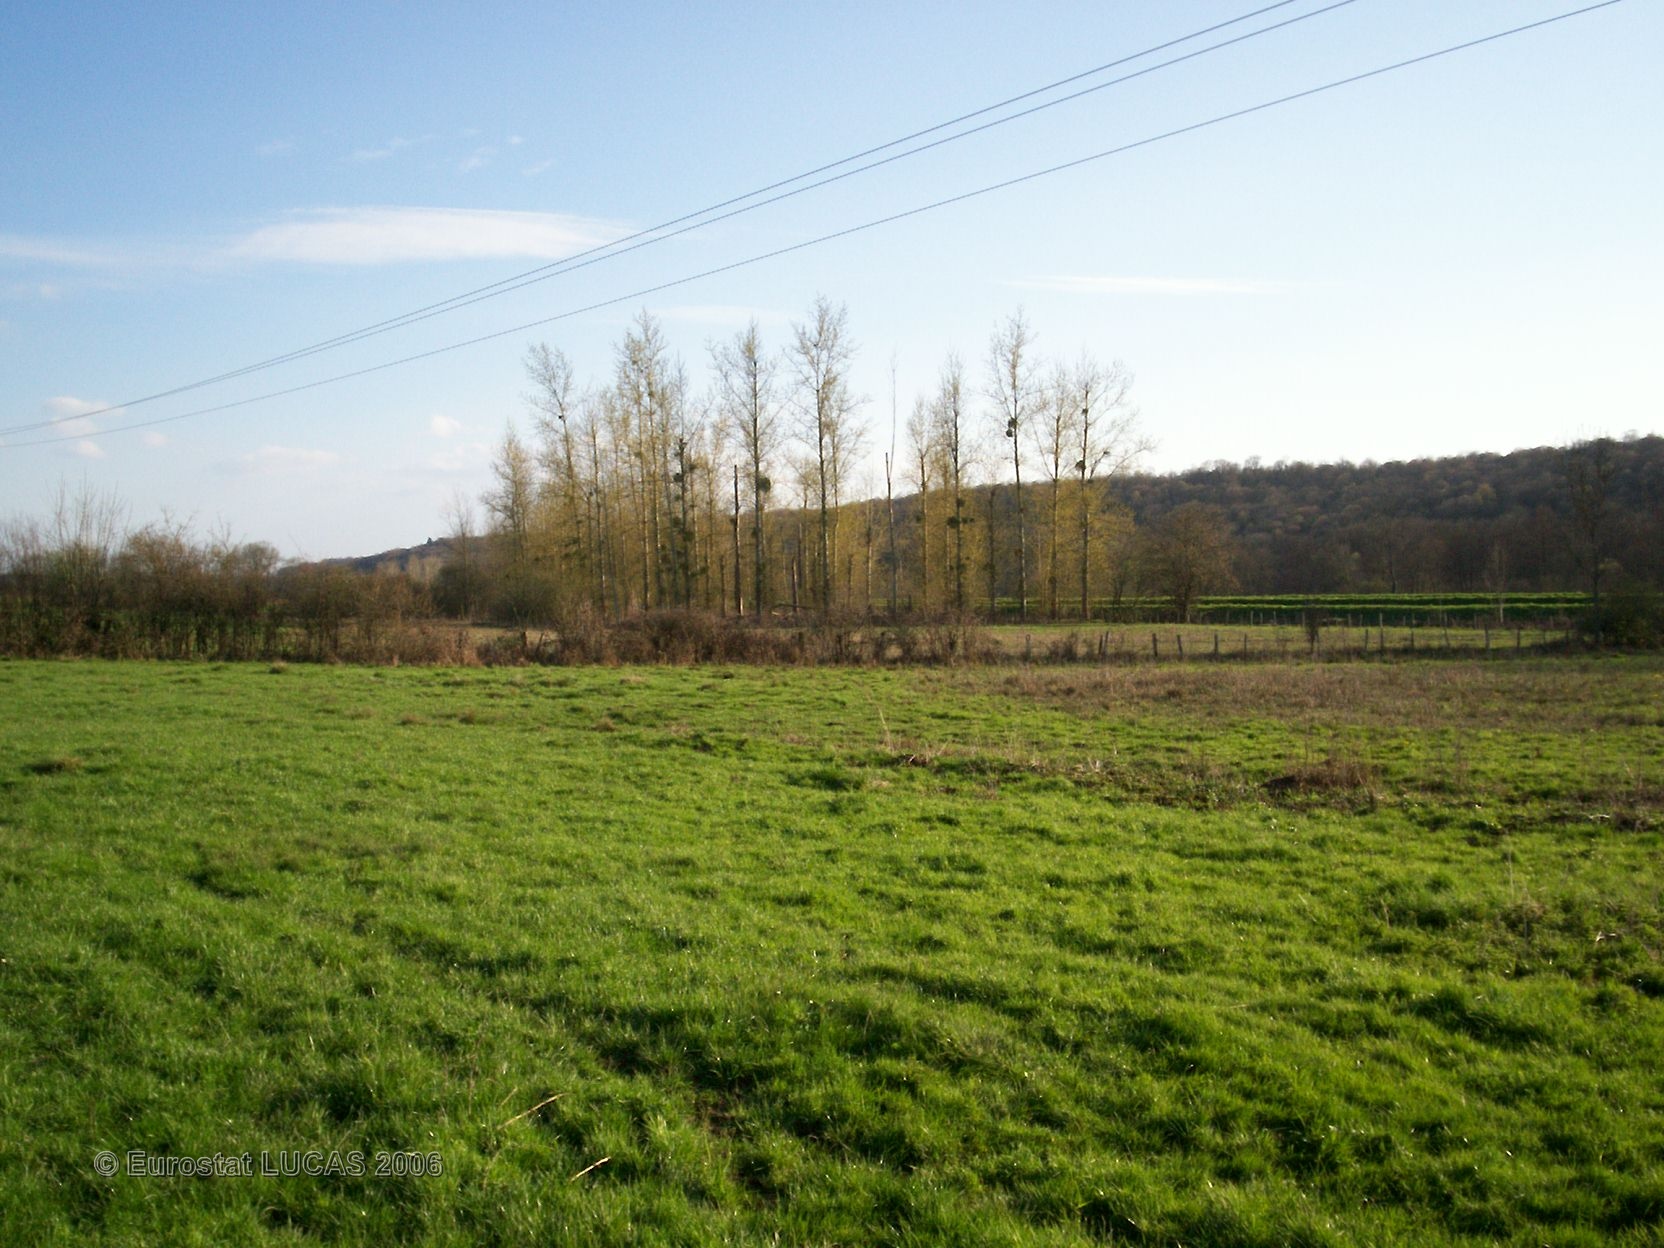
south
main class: Grassland
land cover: Grassland without tree/shrub cover
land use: Agriculture (excluding fallow land and kitchen gardens)
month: April
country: FR
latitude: 47.9958
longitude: 5.2689
